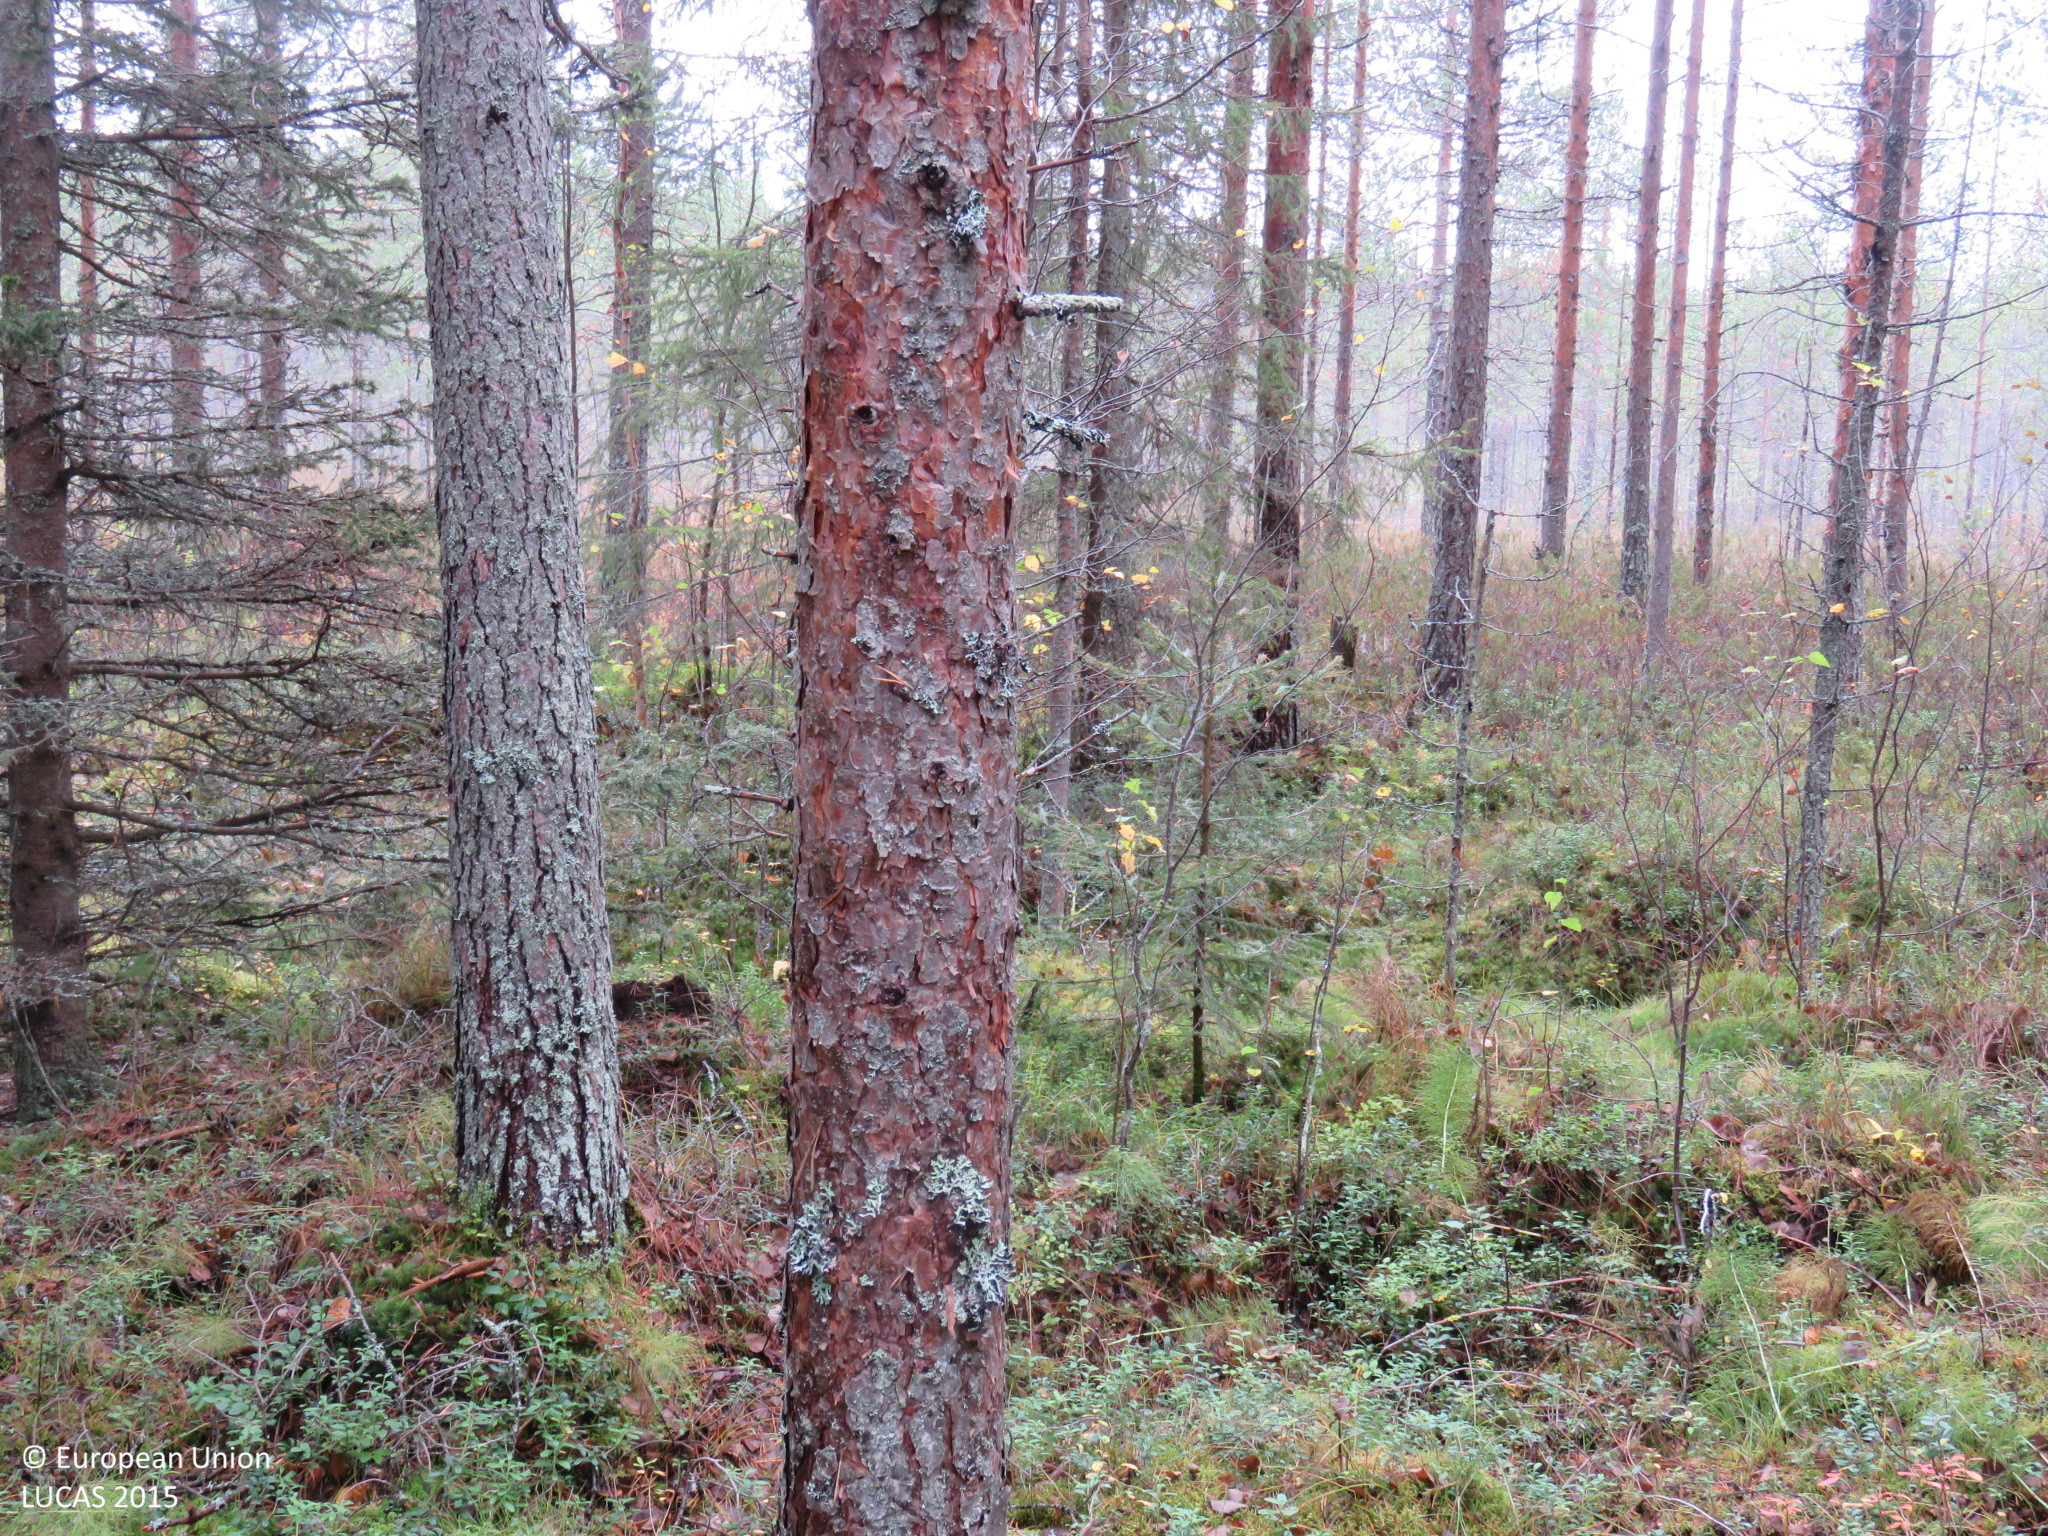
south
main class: Woodland
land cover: Other coniferous woodland
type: boreal forest
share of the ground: > 75 %
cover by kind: coniferous forest trees 70 %, shrubs 15 %, broadleaved forest trees 10 %, lichens and mosses 5 %
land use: Forestry
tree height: > 5 m
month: September
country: FI
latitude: 64.9528
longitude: 27.0377
